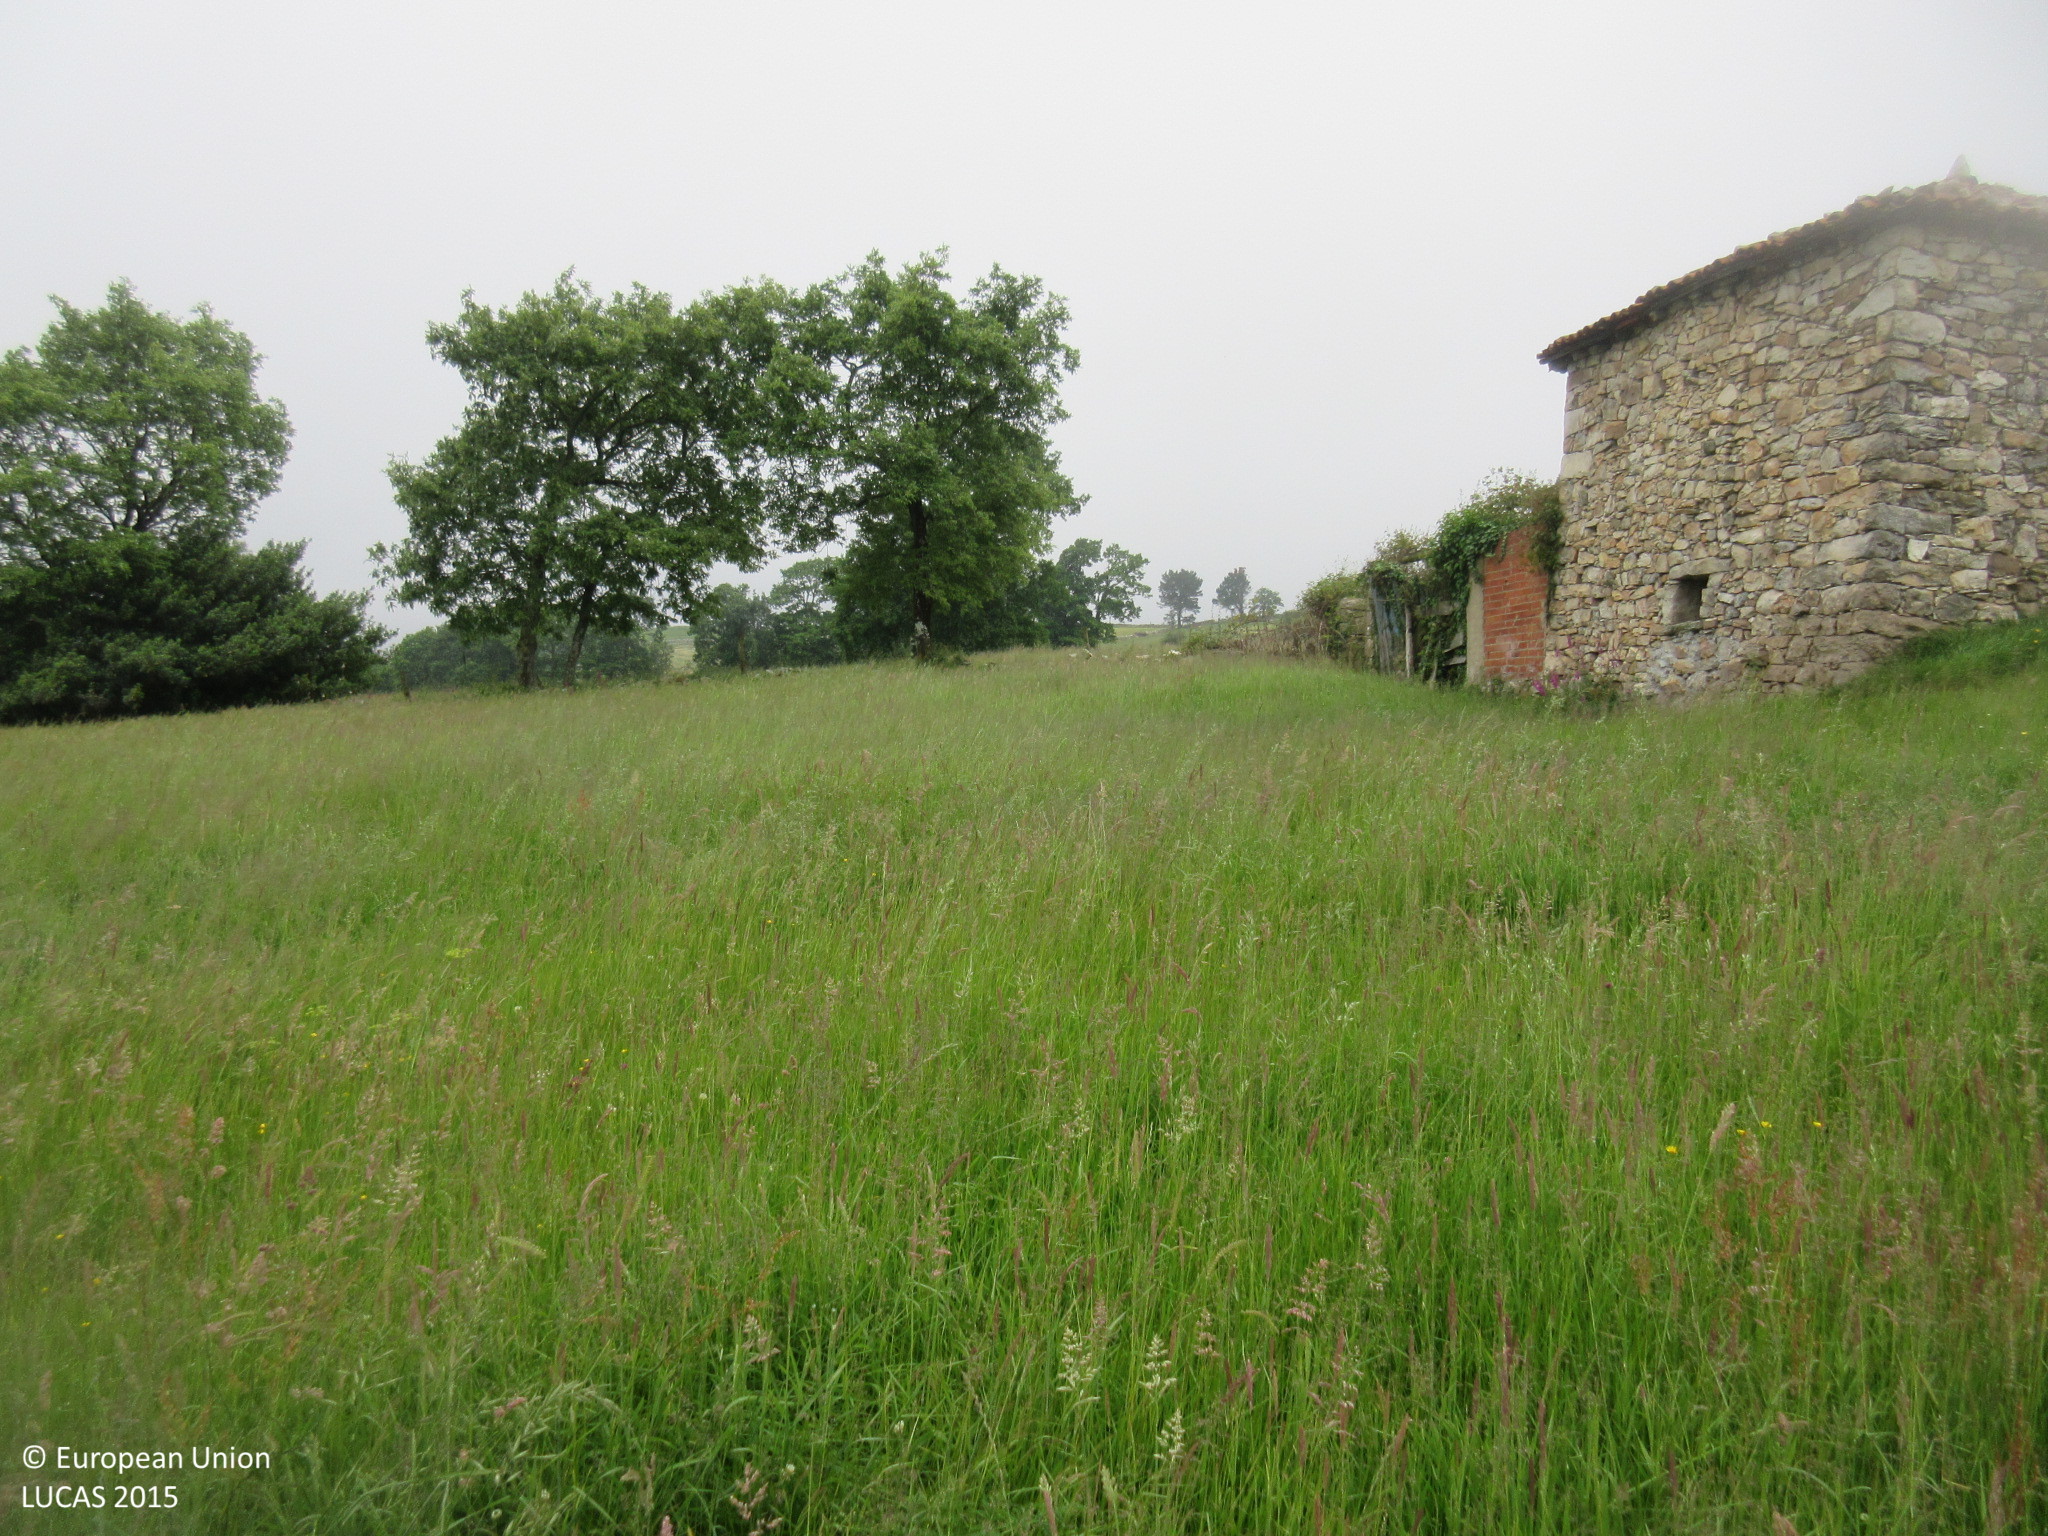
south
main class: Grassland
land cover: Grassland without tree/shrub cover
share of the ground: > 75 %
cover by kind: herbaceous plants 100 %
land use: Agriculture (excluding fallow land and kitchen gardens)
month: June
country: ES
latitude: 43.3635
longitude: -6.3002
